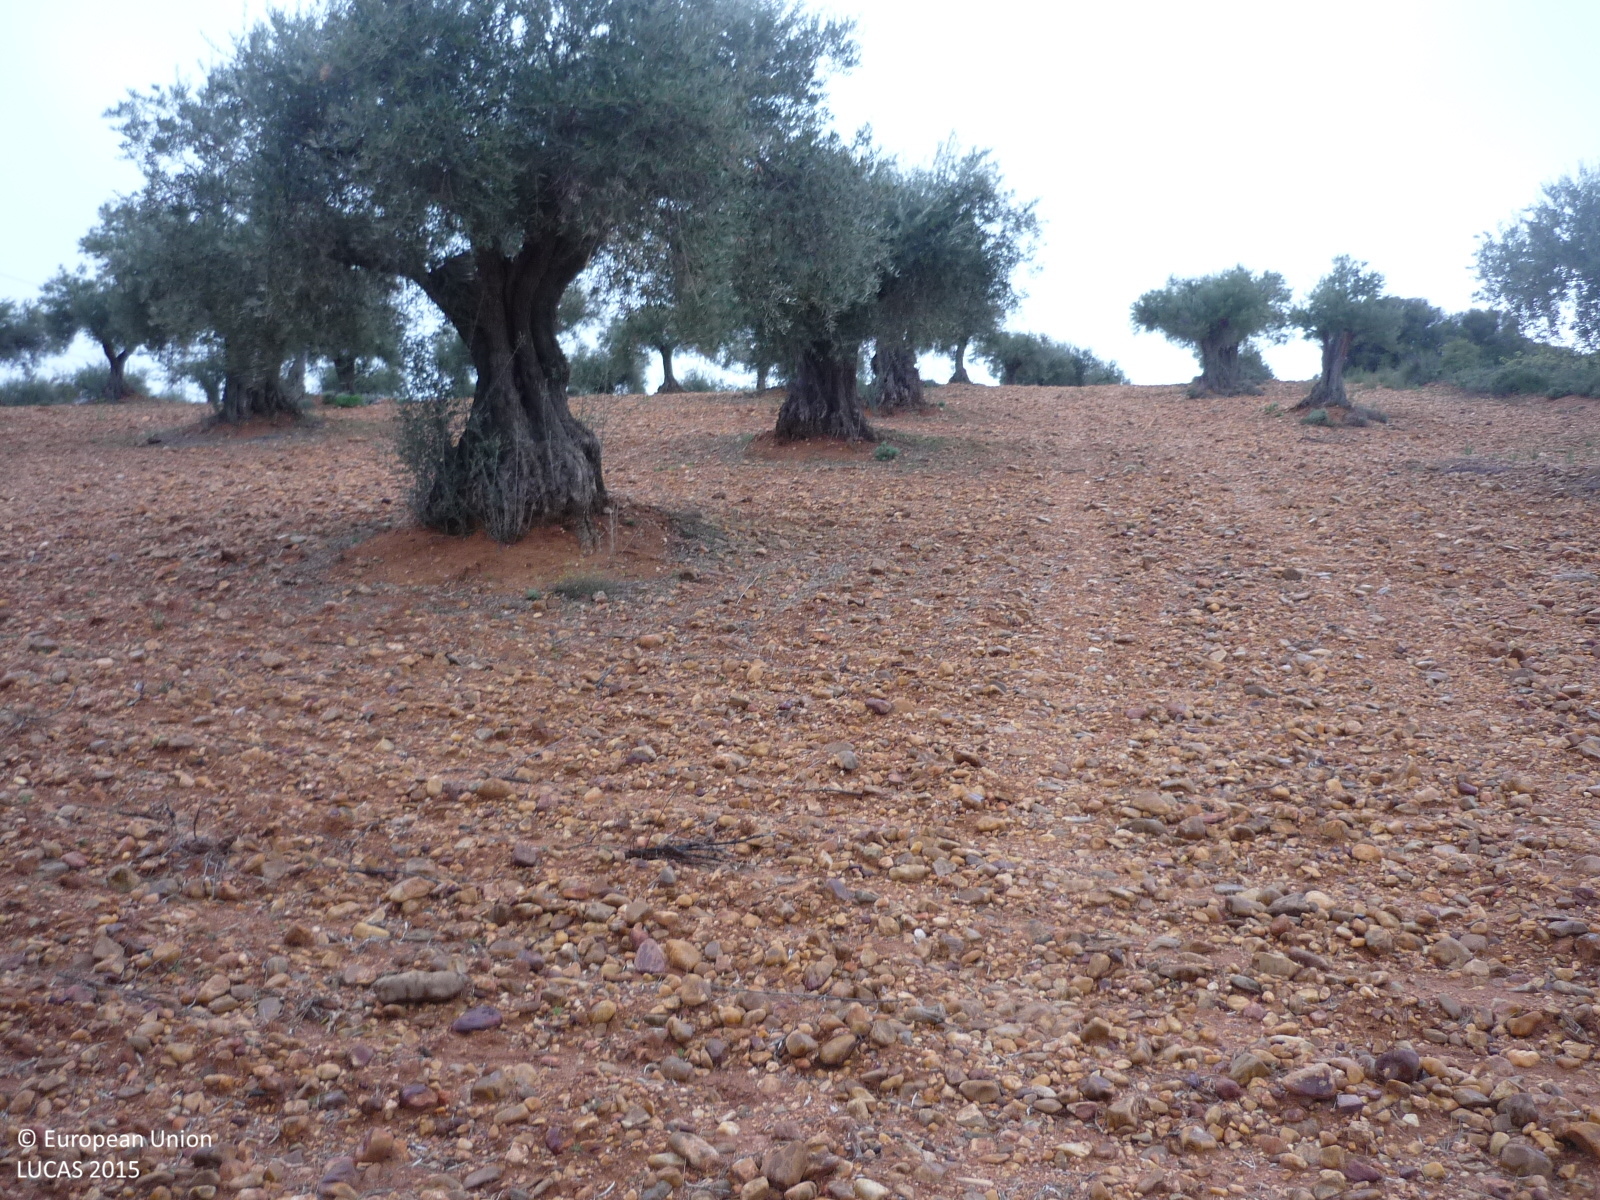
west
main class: Cropland
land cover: Olive groves
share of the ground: 10 - 25 %
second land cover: Other bare soil
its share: > 75 %
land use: Agriculture (excluding fallow land and kitchen gardens)
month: April
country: ES
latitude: 40.3721
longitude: -3.3766
